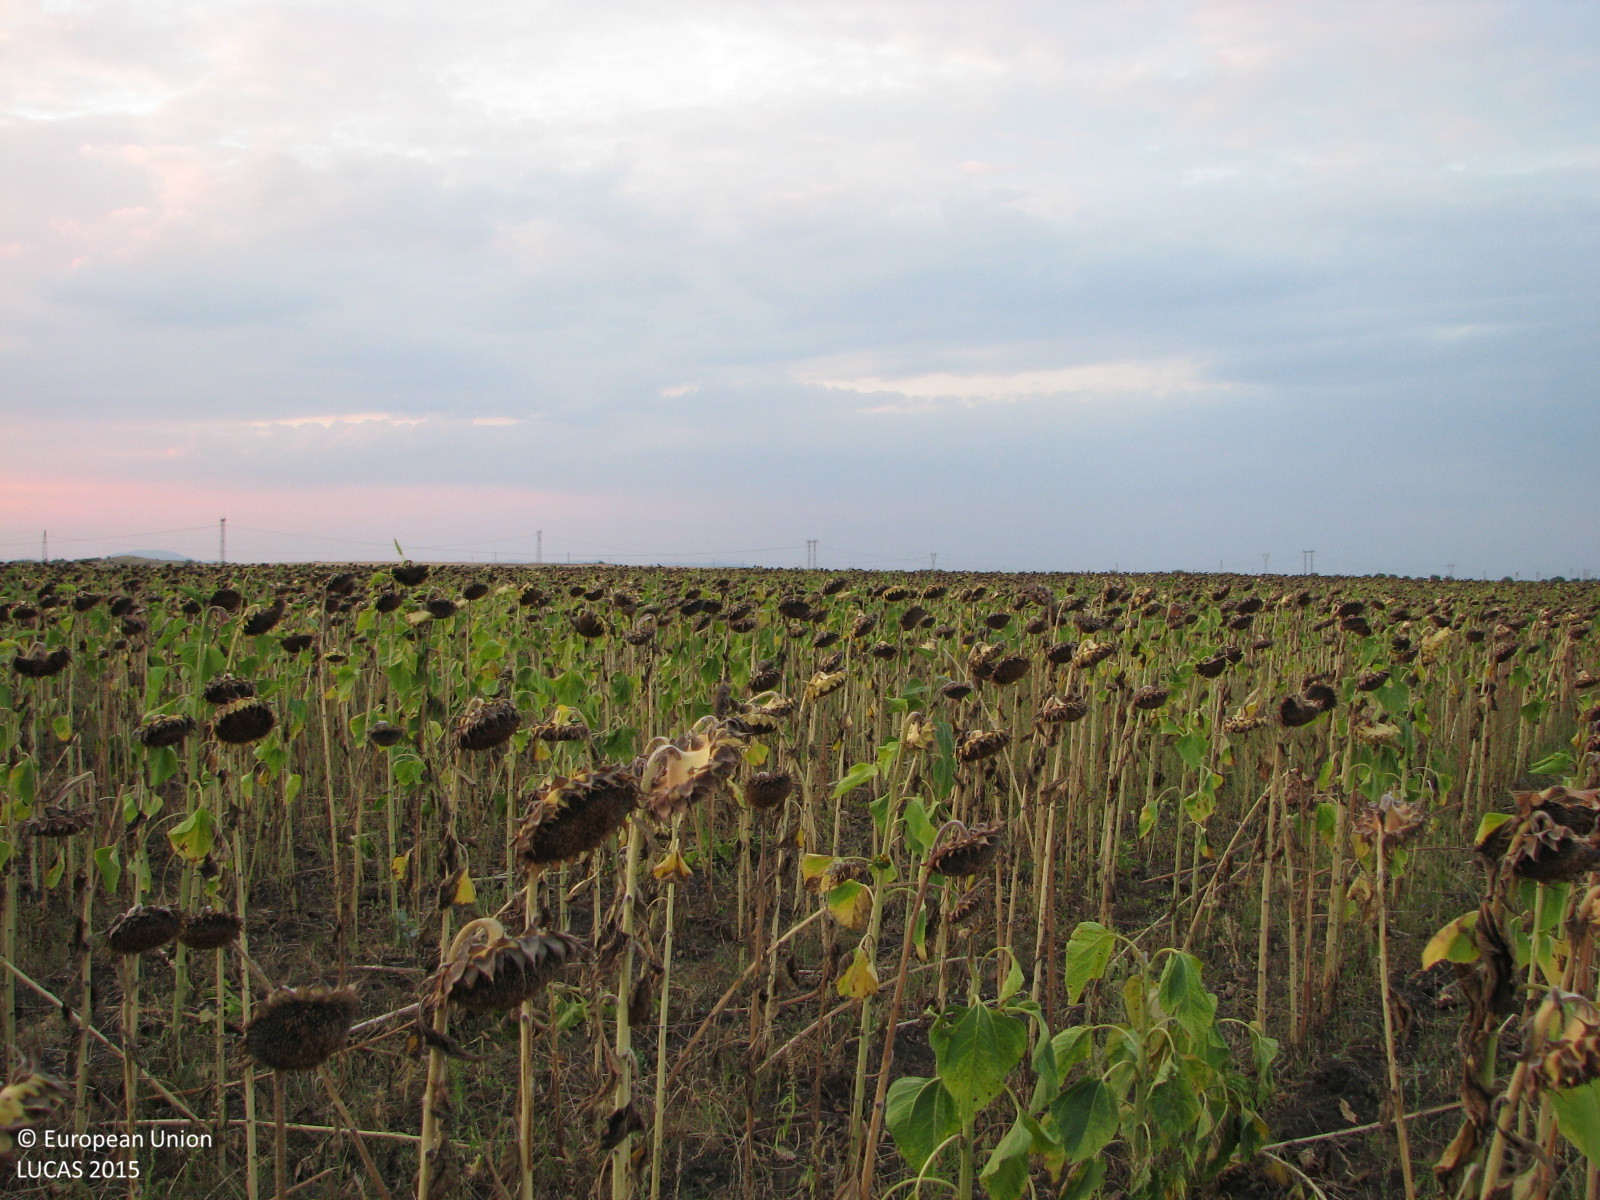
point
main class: Cropland
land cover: Sunflower
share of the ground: > 75 %
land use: Agriculture (excluding fallow land and kitchen gardens)
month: August
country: BG
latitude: 42.4730
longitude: 26.5750
